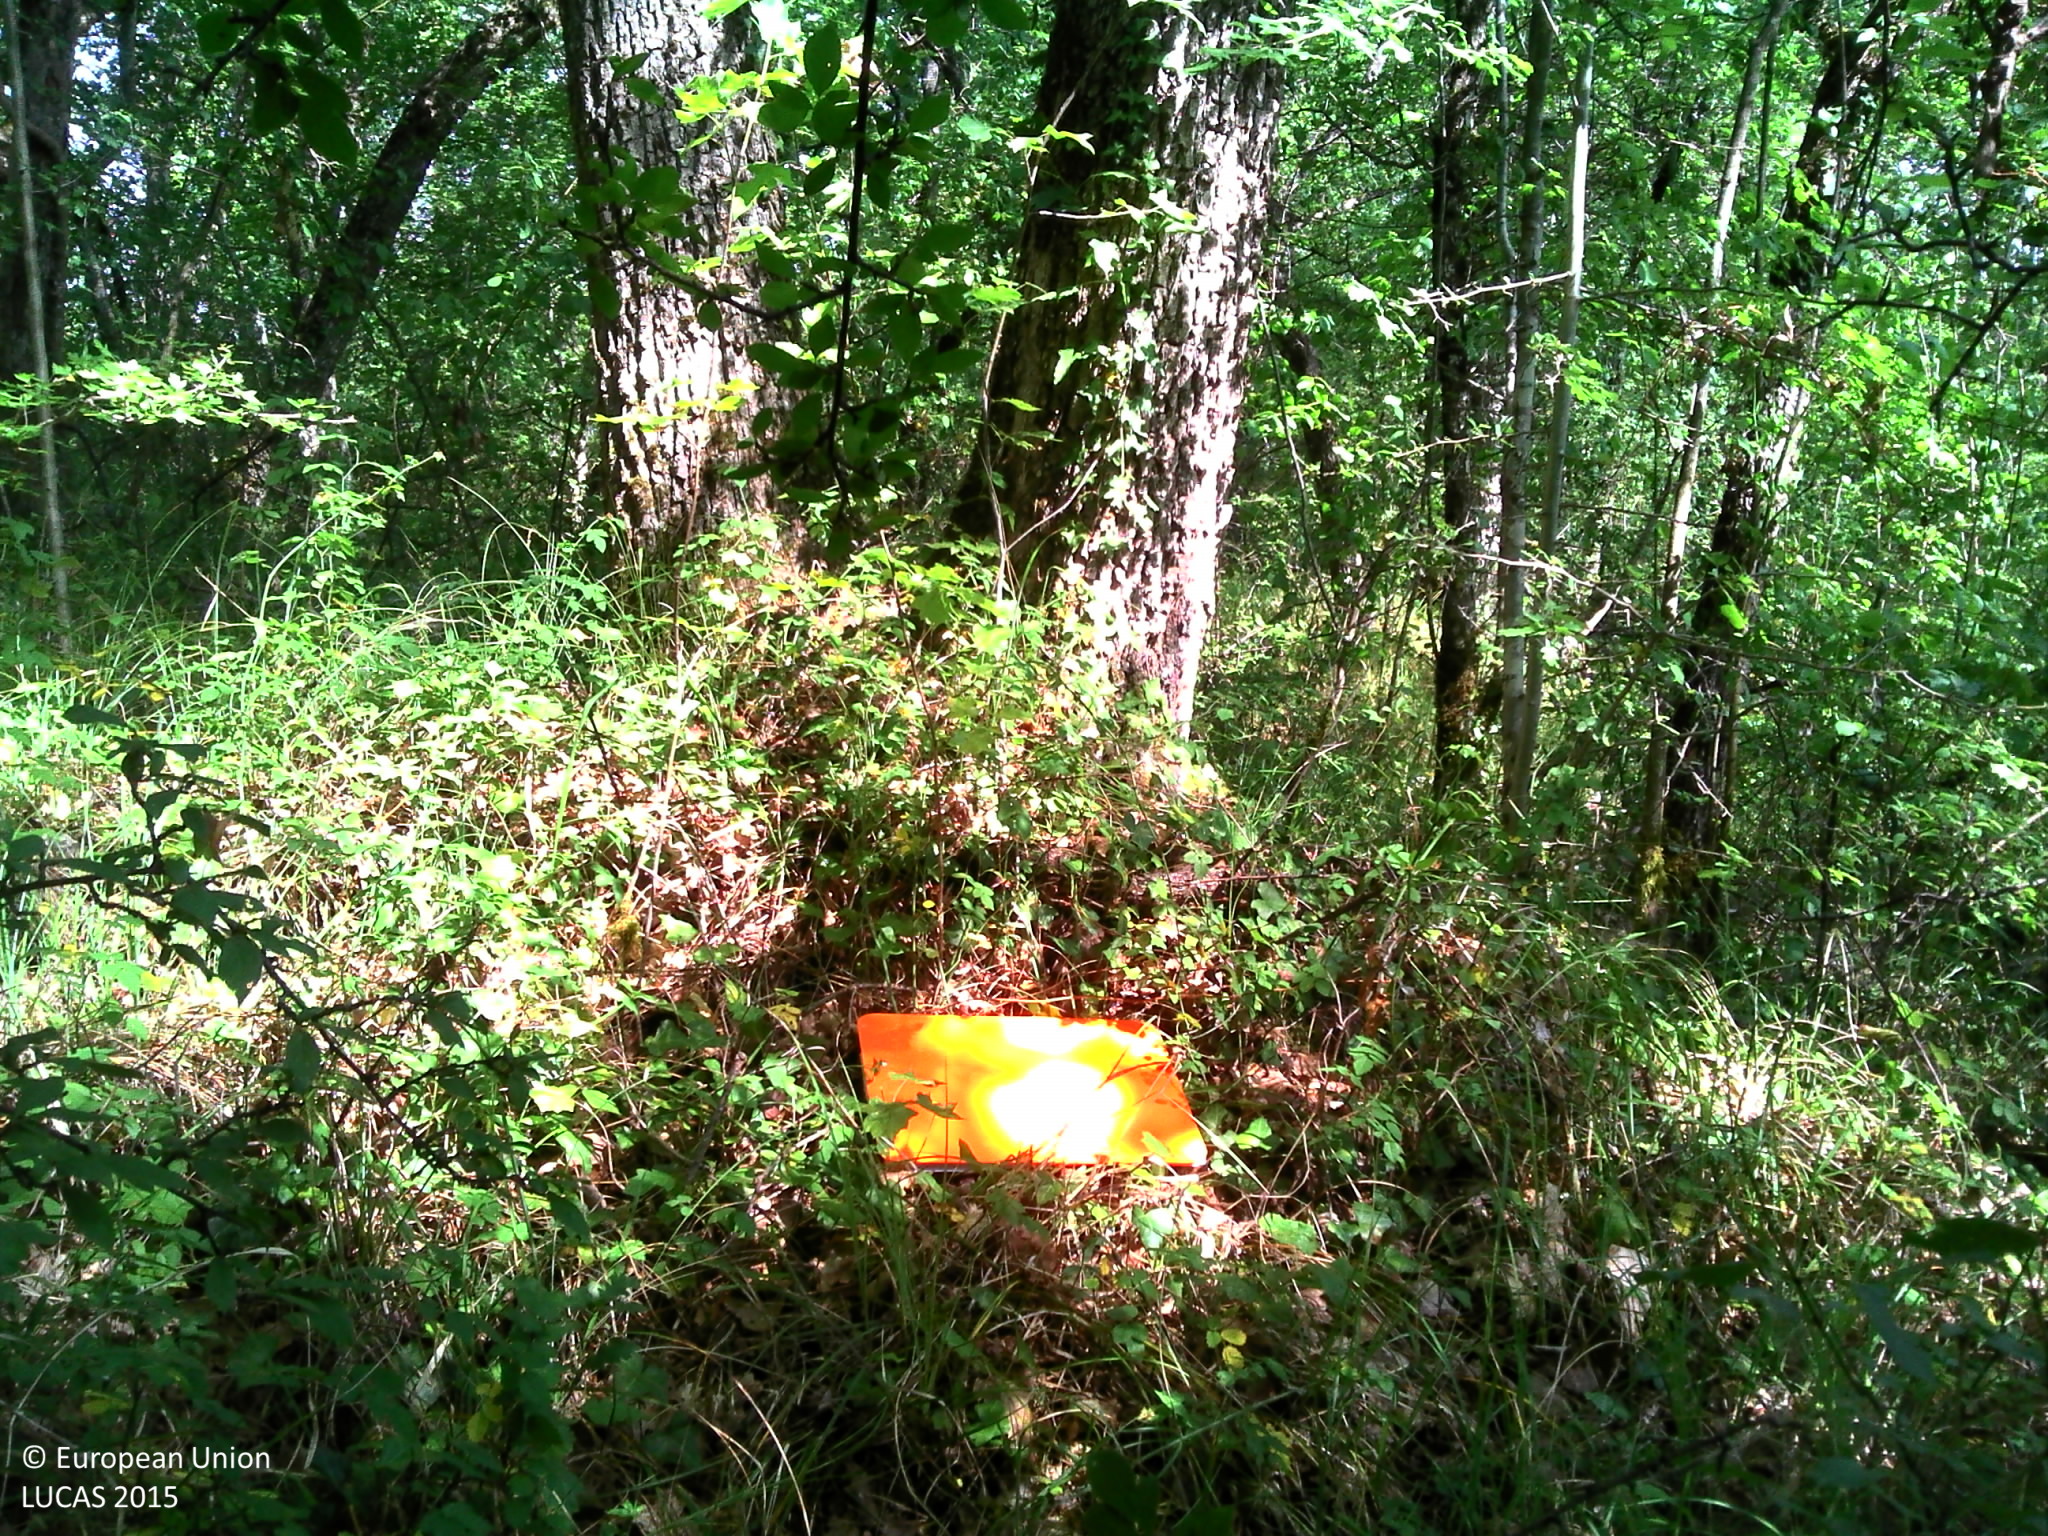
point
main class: Woodland
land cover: Broadleaved woodland
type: thermophilous deciduous forest
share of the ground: > 75 %
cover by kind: broadleaved forest trees 95 %, coniferous forest trees 5 %
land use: Forestry
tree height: > 5 m
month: July
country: FR
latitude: 44.5302
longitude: 0.8968
